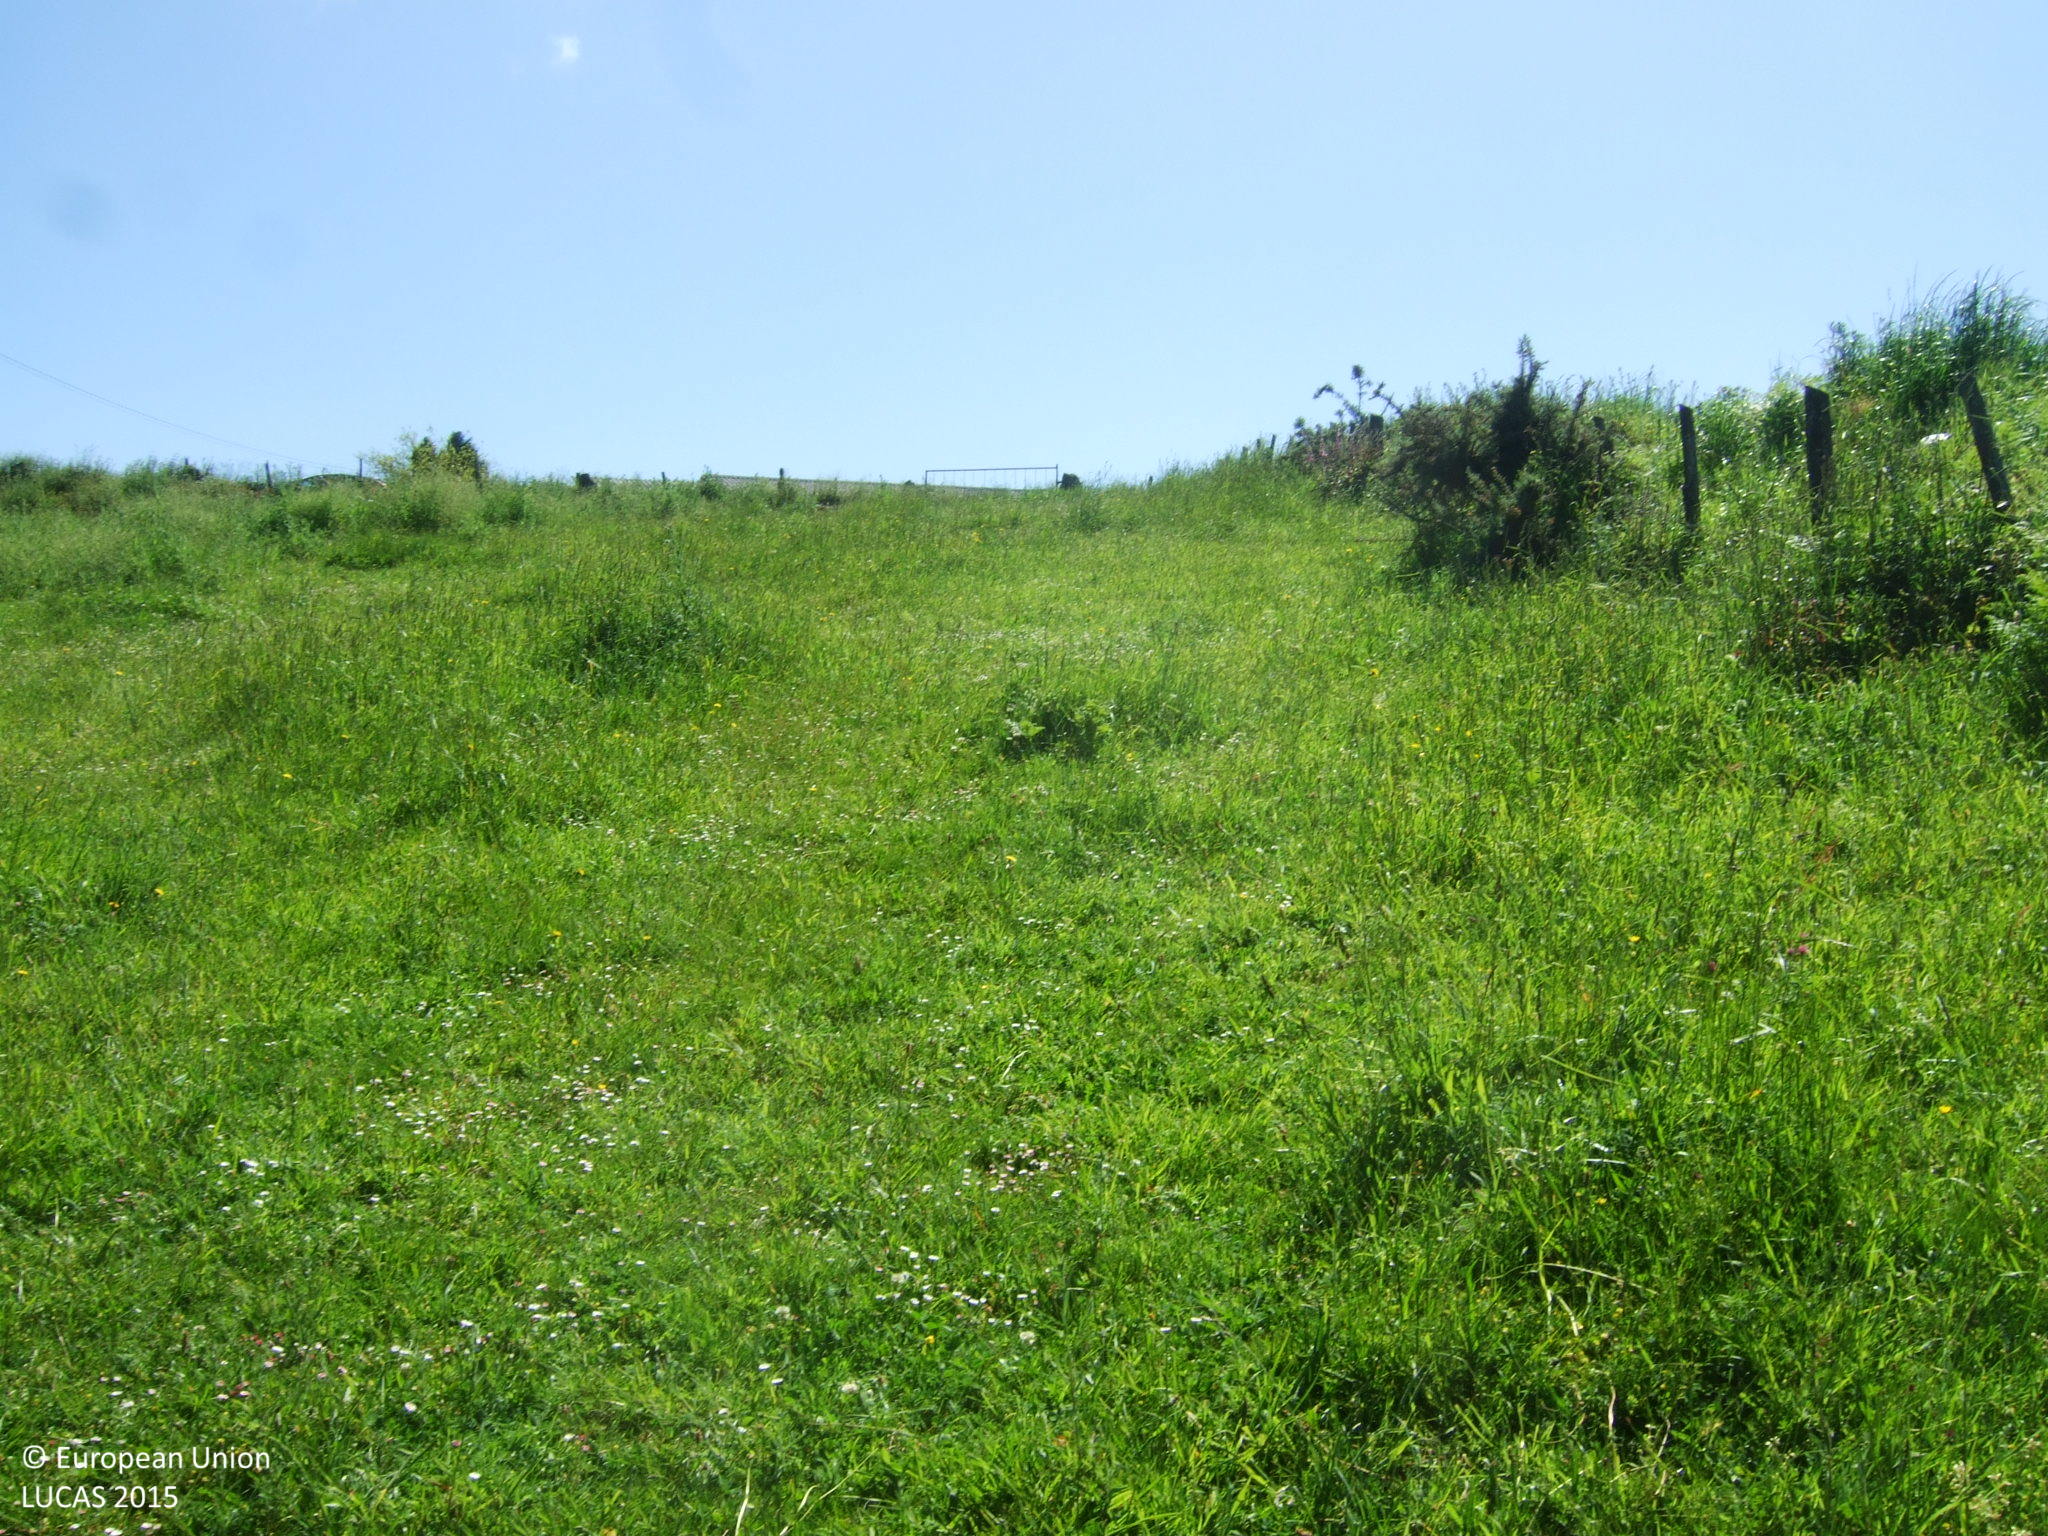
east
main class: Grassland
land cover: Grassland without tree/shrub cover
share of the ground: > 75 %
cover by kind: herbaceous plants 100 %
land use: Agriculture (excluding fallow land and kitchen gardens)
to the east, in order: Grassland without tree/shrub cover; Fences; Paved roads, cycling and walking lanes; Grassland without tree/shrub cover; Artificial constructions in urban areas; Temporary grasslands; Fences; Temporary grasslands; Fences; Temporary grasslands; Shruby margins; Temporary grasslands
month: May
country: ES
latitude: 42.7430
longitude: -7.5799
